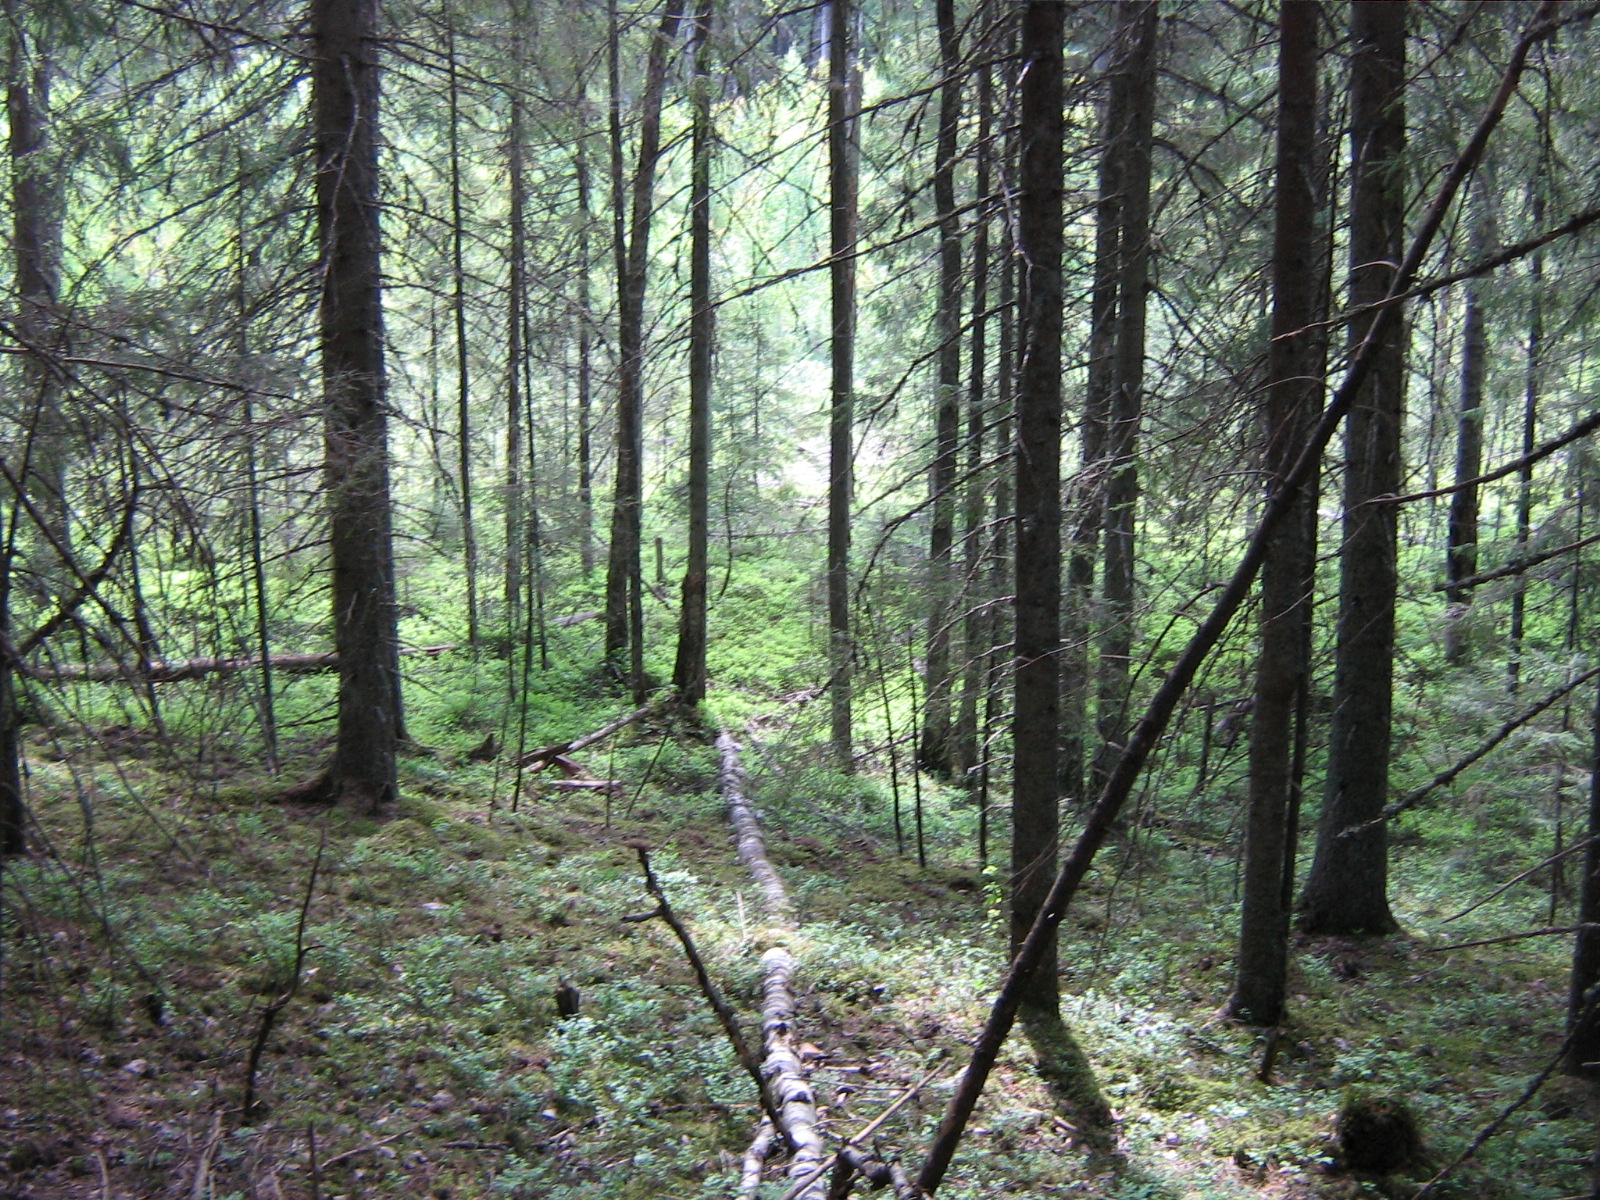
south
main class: Woodland
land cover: Spruce dominated coniferous woodland
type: hemiboreal forest and nemoral coniferous forest and mixed broadleaved-coniferous forest
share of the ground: > 75 %
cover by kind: coniferous forest trees 100 %
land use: Forestry
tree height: > 5 m
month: June
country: LV
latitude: 57.0467
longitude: 25.2596
